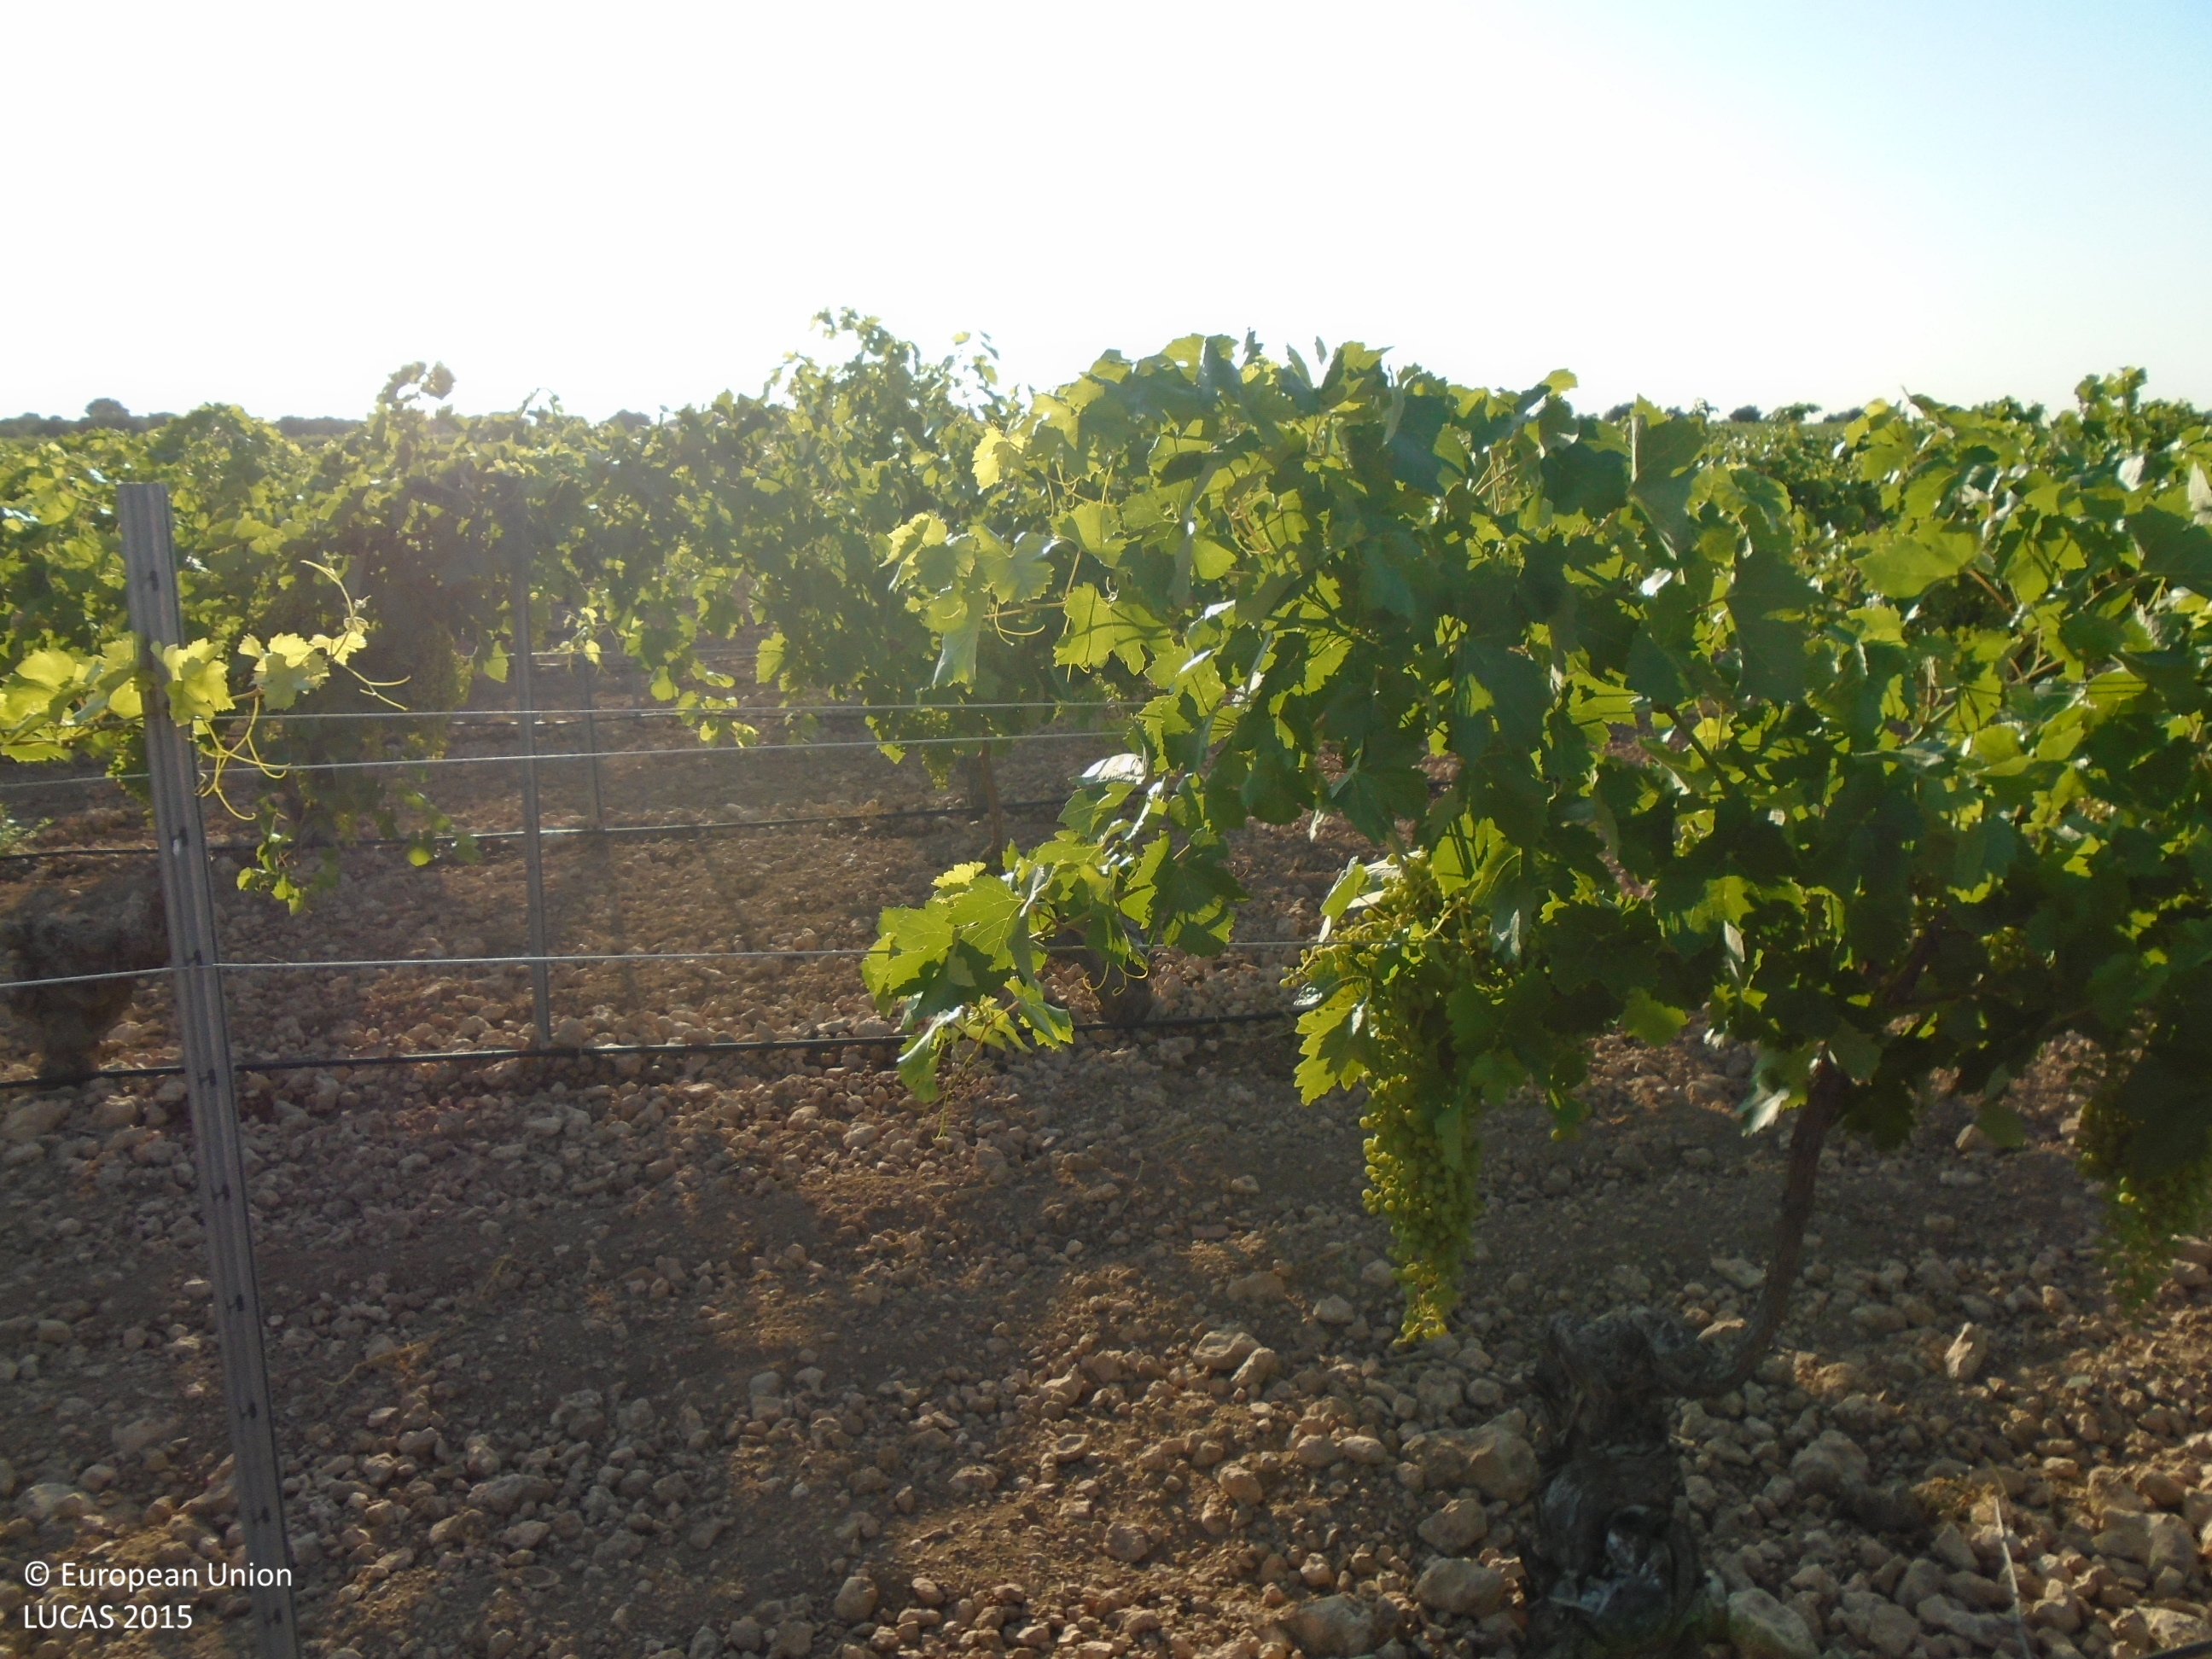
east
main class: Cropland
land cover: Vineyards
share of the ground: 10 - 25 %
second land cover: Other bare soil
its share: > 75 %
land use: Agriculture (excluding fallow land and kitchen gardens)
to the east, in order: Vineyards; Other bare soil; Grass margins; Vineyards; Grass margins; Olive groves; Grass margins; Tracks; Grass margins; Vineyards
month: June
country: ES
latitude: 39.1484
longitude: -3.6149
